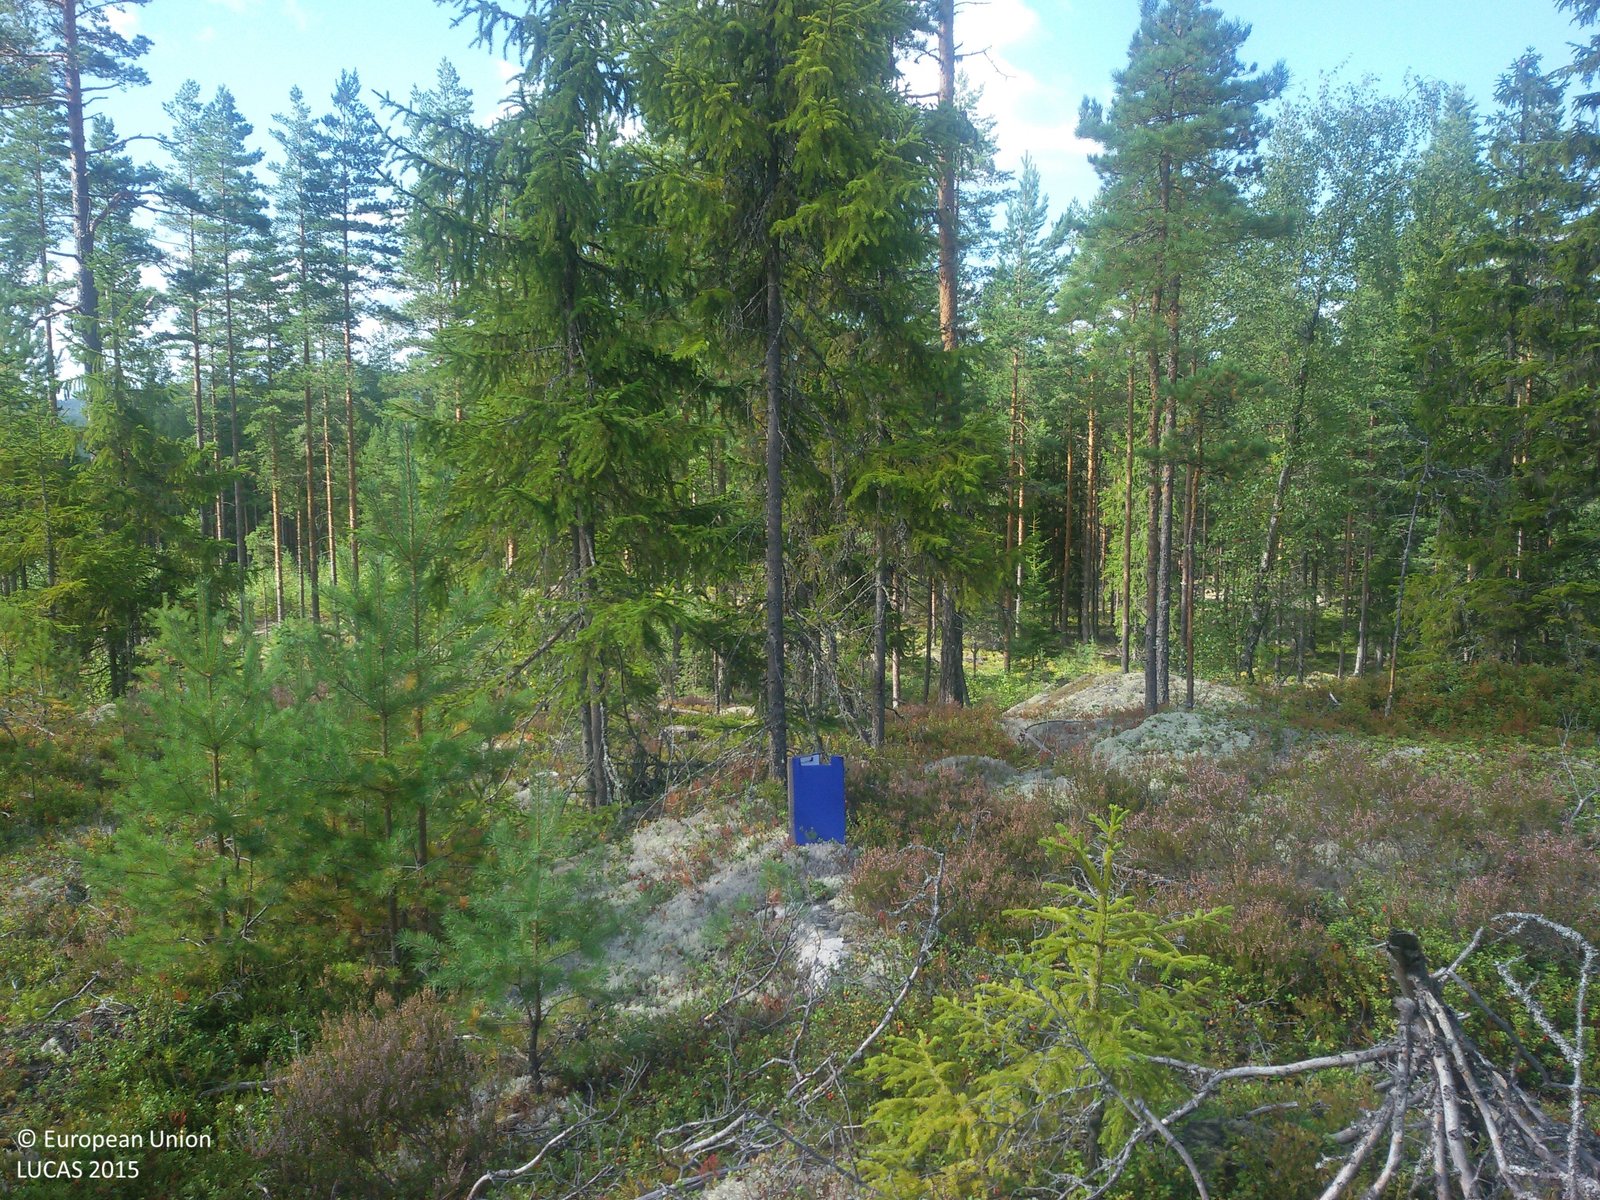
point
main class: Woodland
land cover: Pine dominated mixed woodland
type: boreal forest
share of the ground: 50 - 75 %
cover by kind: herbaceous plants 35 %, coniferous forest trees 30 %, broadleaved forest trees 20 %, lichens and mosses 15 %
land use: Forestry
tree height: < 5 m
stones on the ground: > 50 %
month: August
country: SE
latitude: 60.6952
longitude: 15.7565
